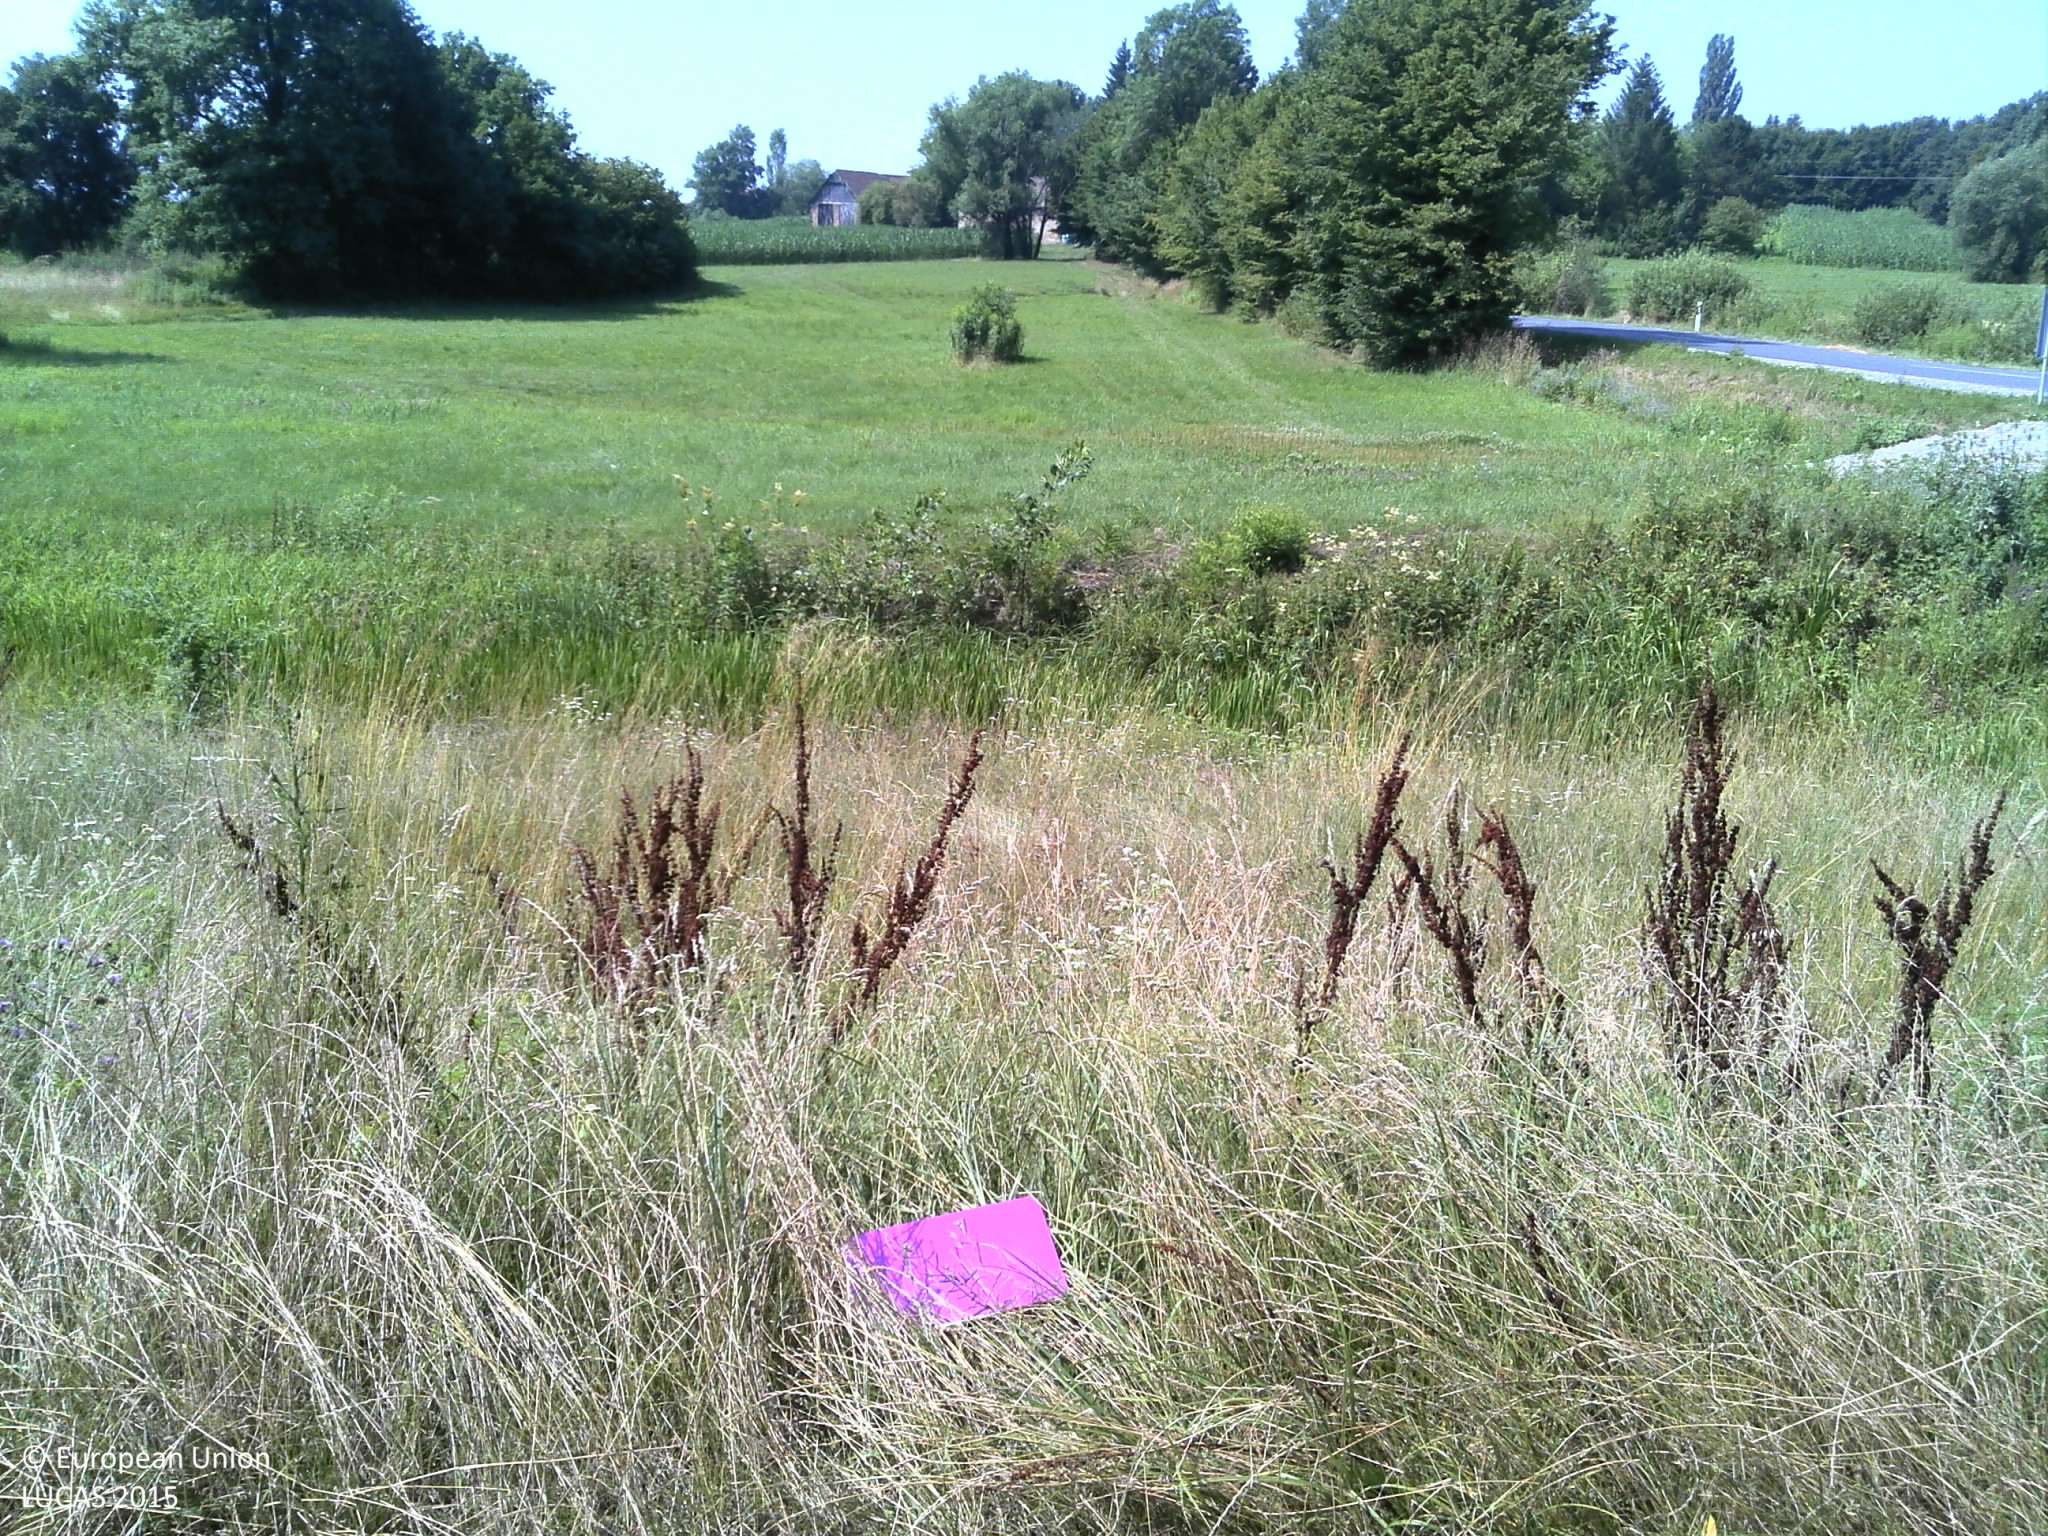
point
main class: Grassland
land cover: Spontaneously vegetated surfaces
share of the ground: > 75 %
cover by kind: herbaceous plants 100 %
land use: Fallow land
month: July
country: HR
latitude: 45.7876
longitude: 16.5724
